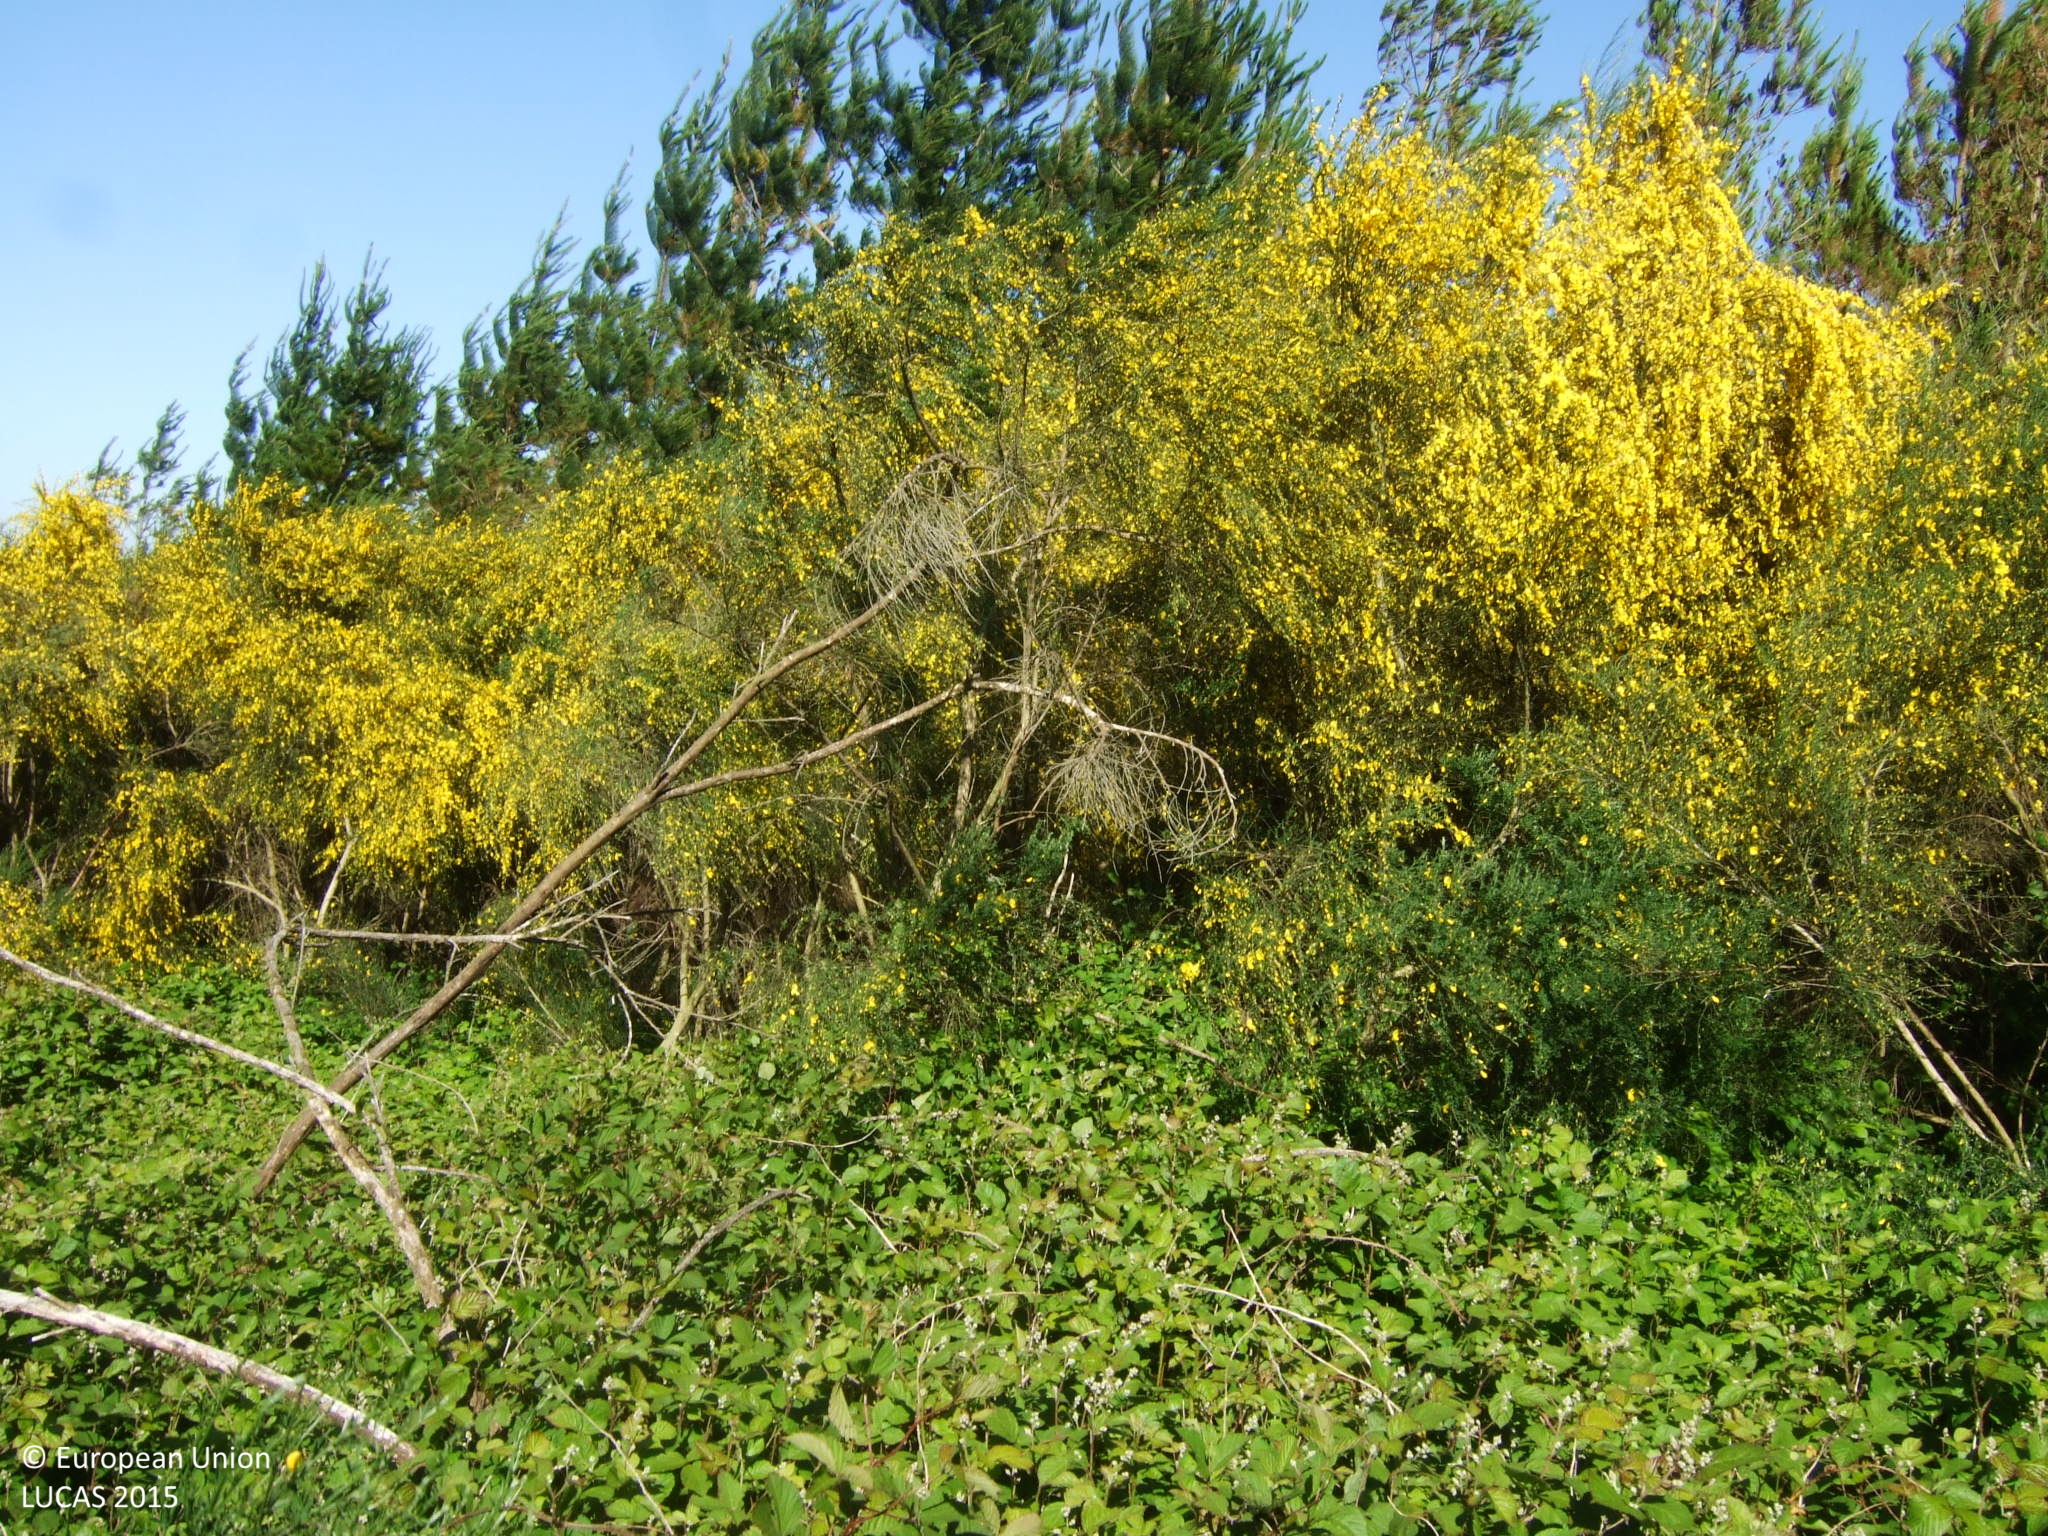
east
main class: Woodland
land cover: Pine dominated coniferous woodland
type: exotic forest
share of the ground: > 75 %
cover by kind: coniferous forest trees 75 %, shrubs 25 %
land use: Forestry
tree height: < 5 m
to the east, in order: Pine dominated coniferous woodland; Grassland without tree/shrub cover; Shrubland without tree cover; Grassland without tree/shrub cover; Paved roads, cycling and walking lanes; Fences; Grassland without tree/shrub cover
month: May
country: ES
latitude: 42.6905
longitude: -7.5641
